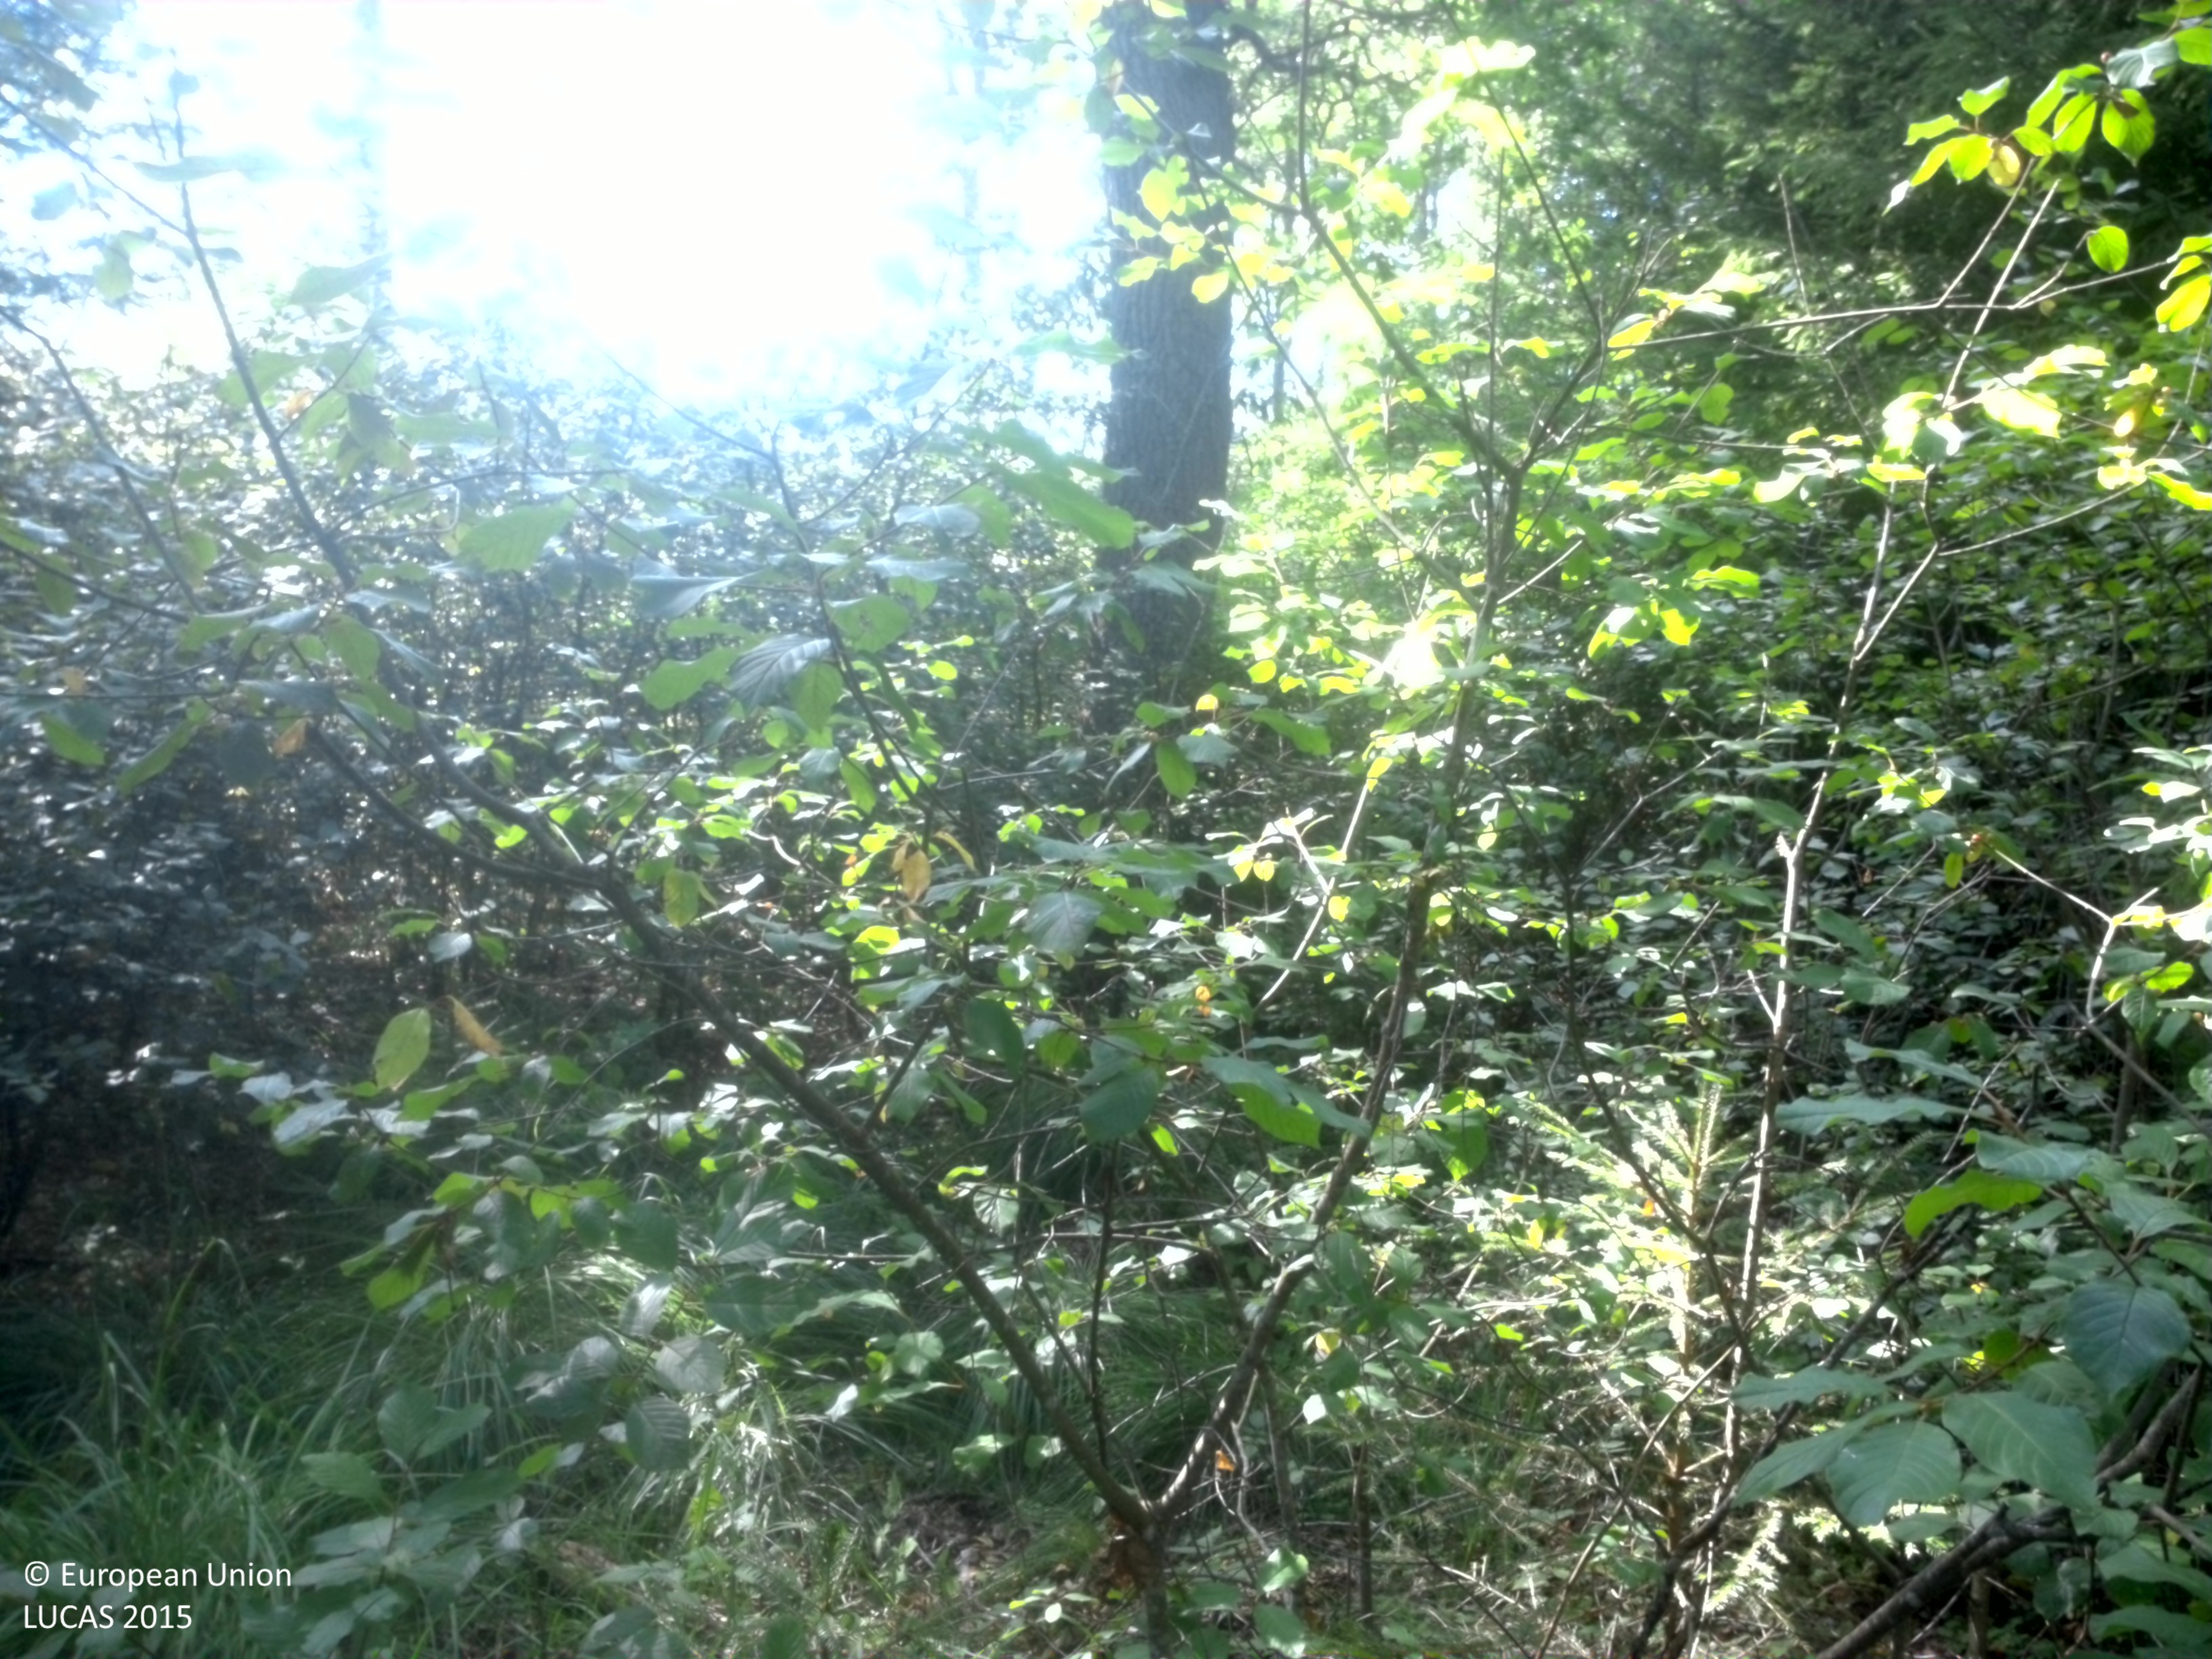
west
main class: Woodland
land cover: Broadleaved woodland
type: boreal forest
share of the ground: 50 - 75 %
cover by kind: broadleaved forest trees 55 %, herbaceous plants 35 %, coniferous forest trees 5 %, shrubs 5 %
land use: Forestry
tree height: > 5 m
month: August
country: SE
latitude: 58.2865
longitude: 13.3203
